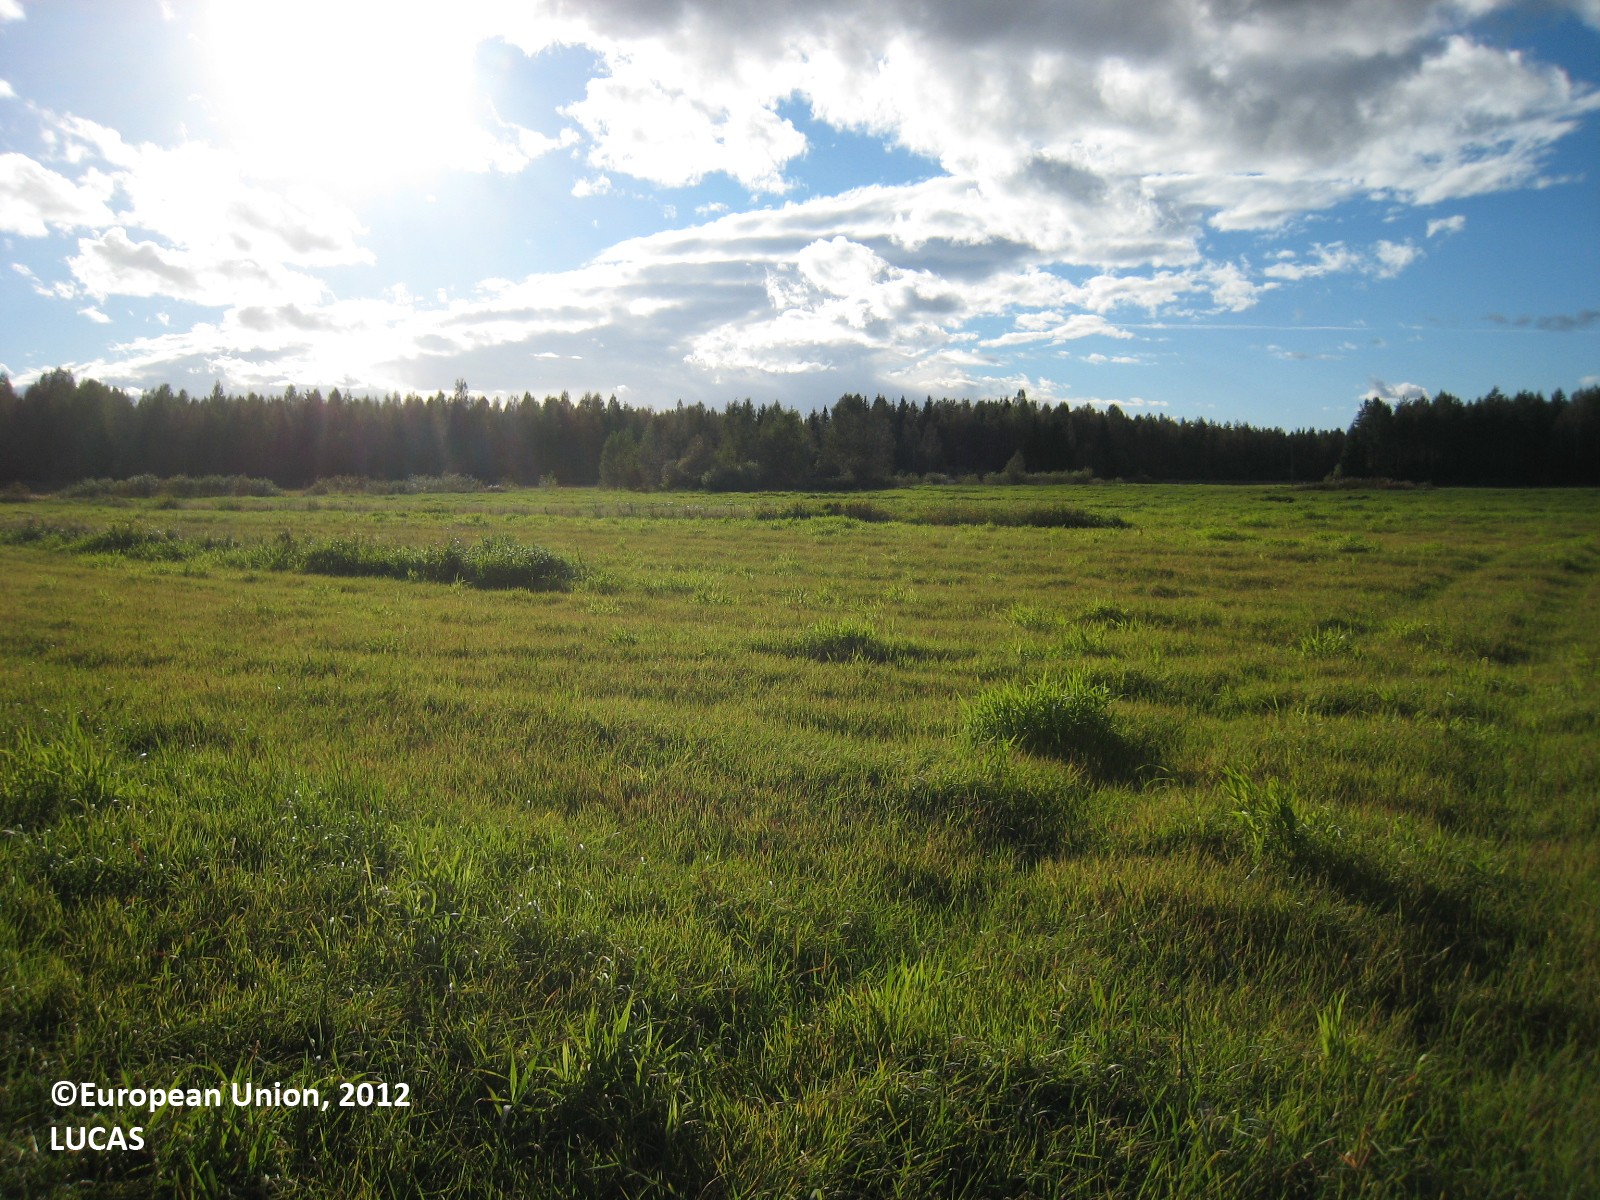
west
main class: Cropland
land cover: Temporary grasslands
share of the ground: > 75 %
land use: Agriculture (excluding fallow land and kitchen gardens)
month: September
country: FI
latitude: 63.1113
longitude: 26.8891
